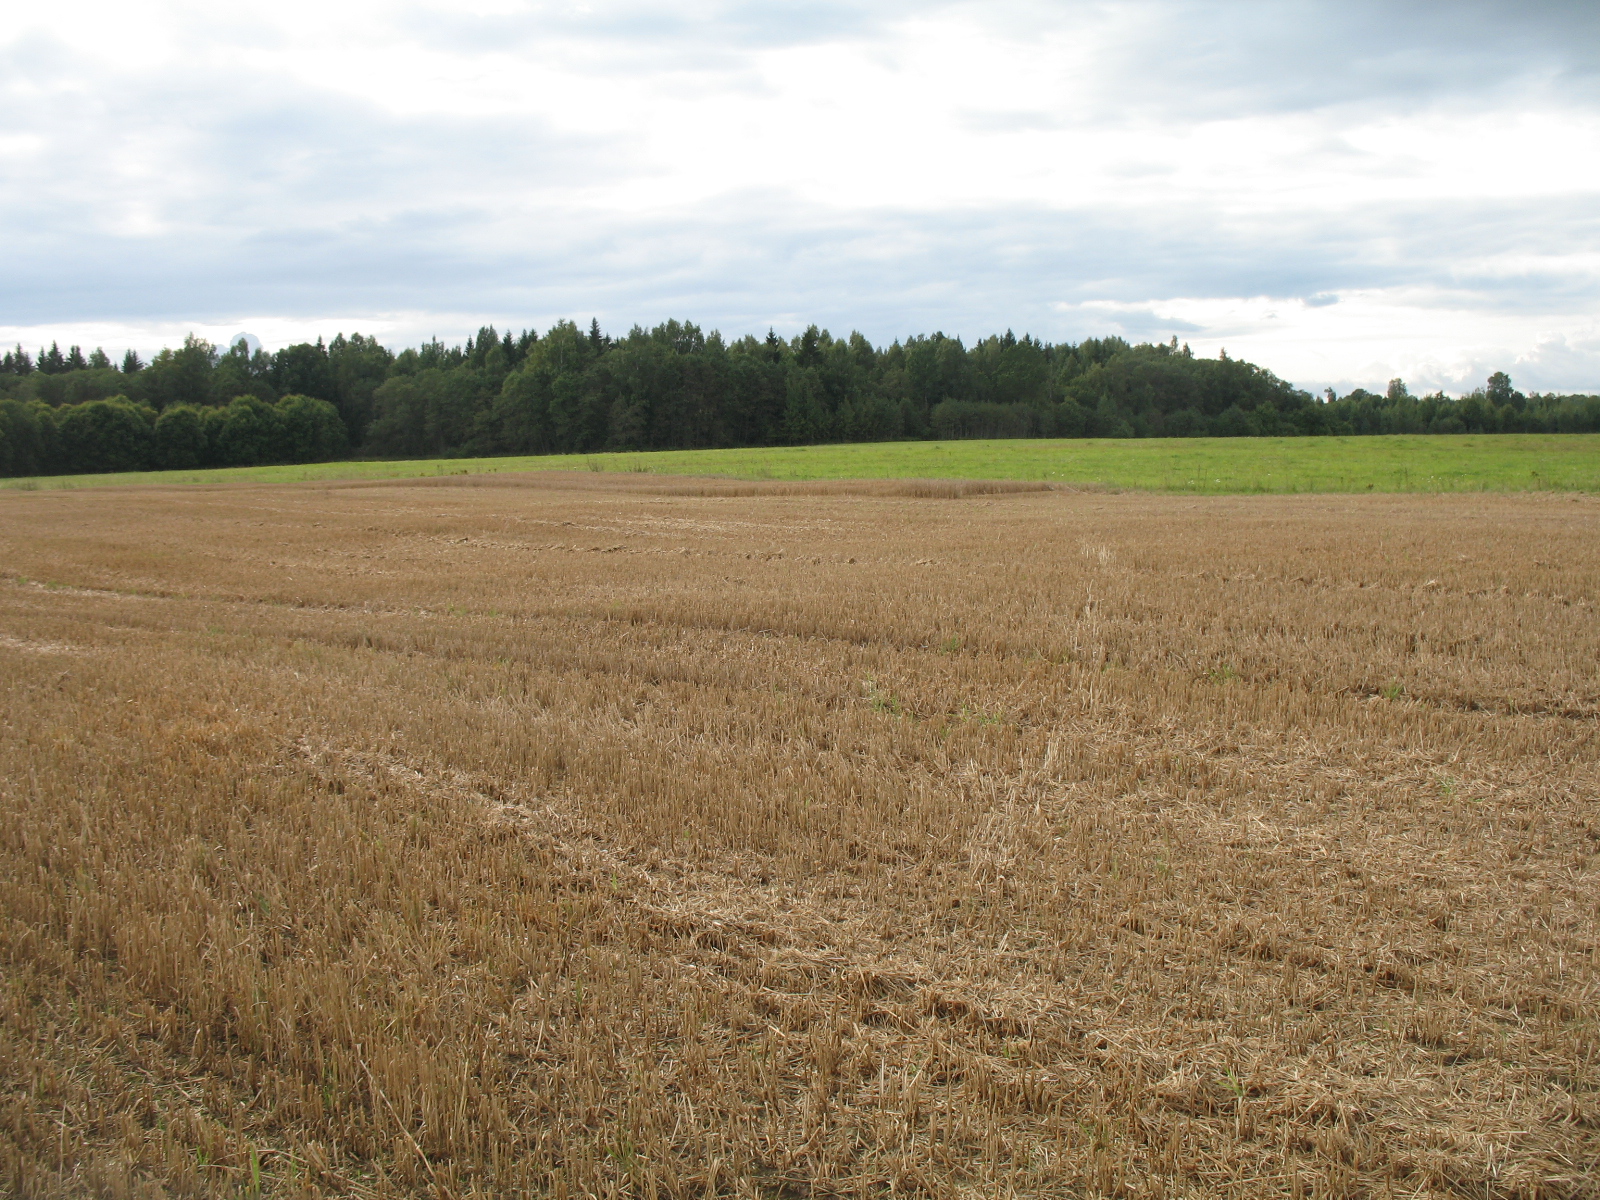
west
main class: Cropland
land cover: Common wheat
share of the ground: < 10 %
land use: Agriculture (excluding fallow land and kitchen gardens)
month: September
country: LV
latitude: 56.0872
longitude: 25.8983
